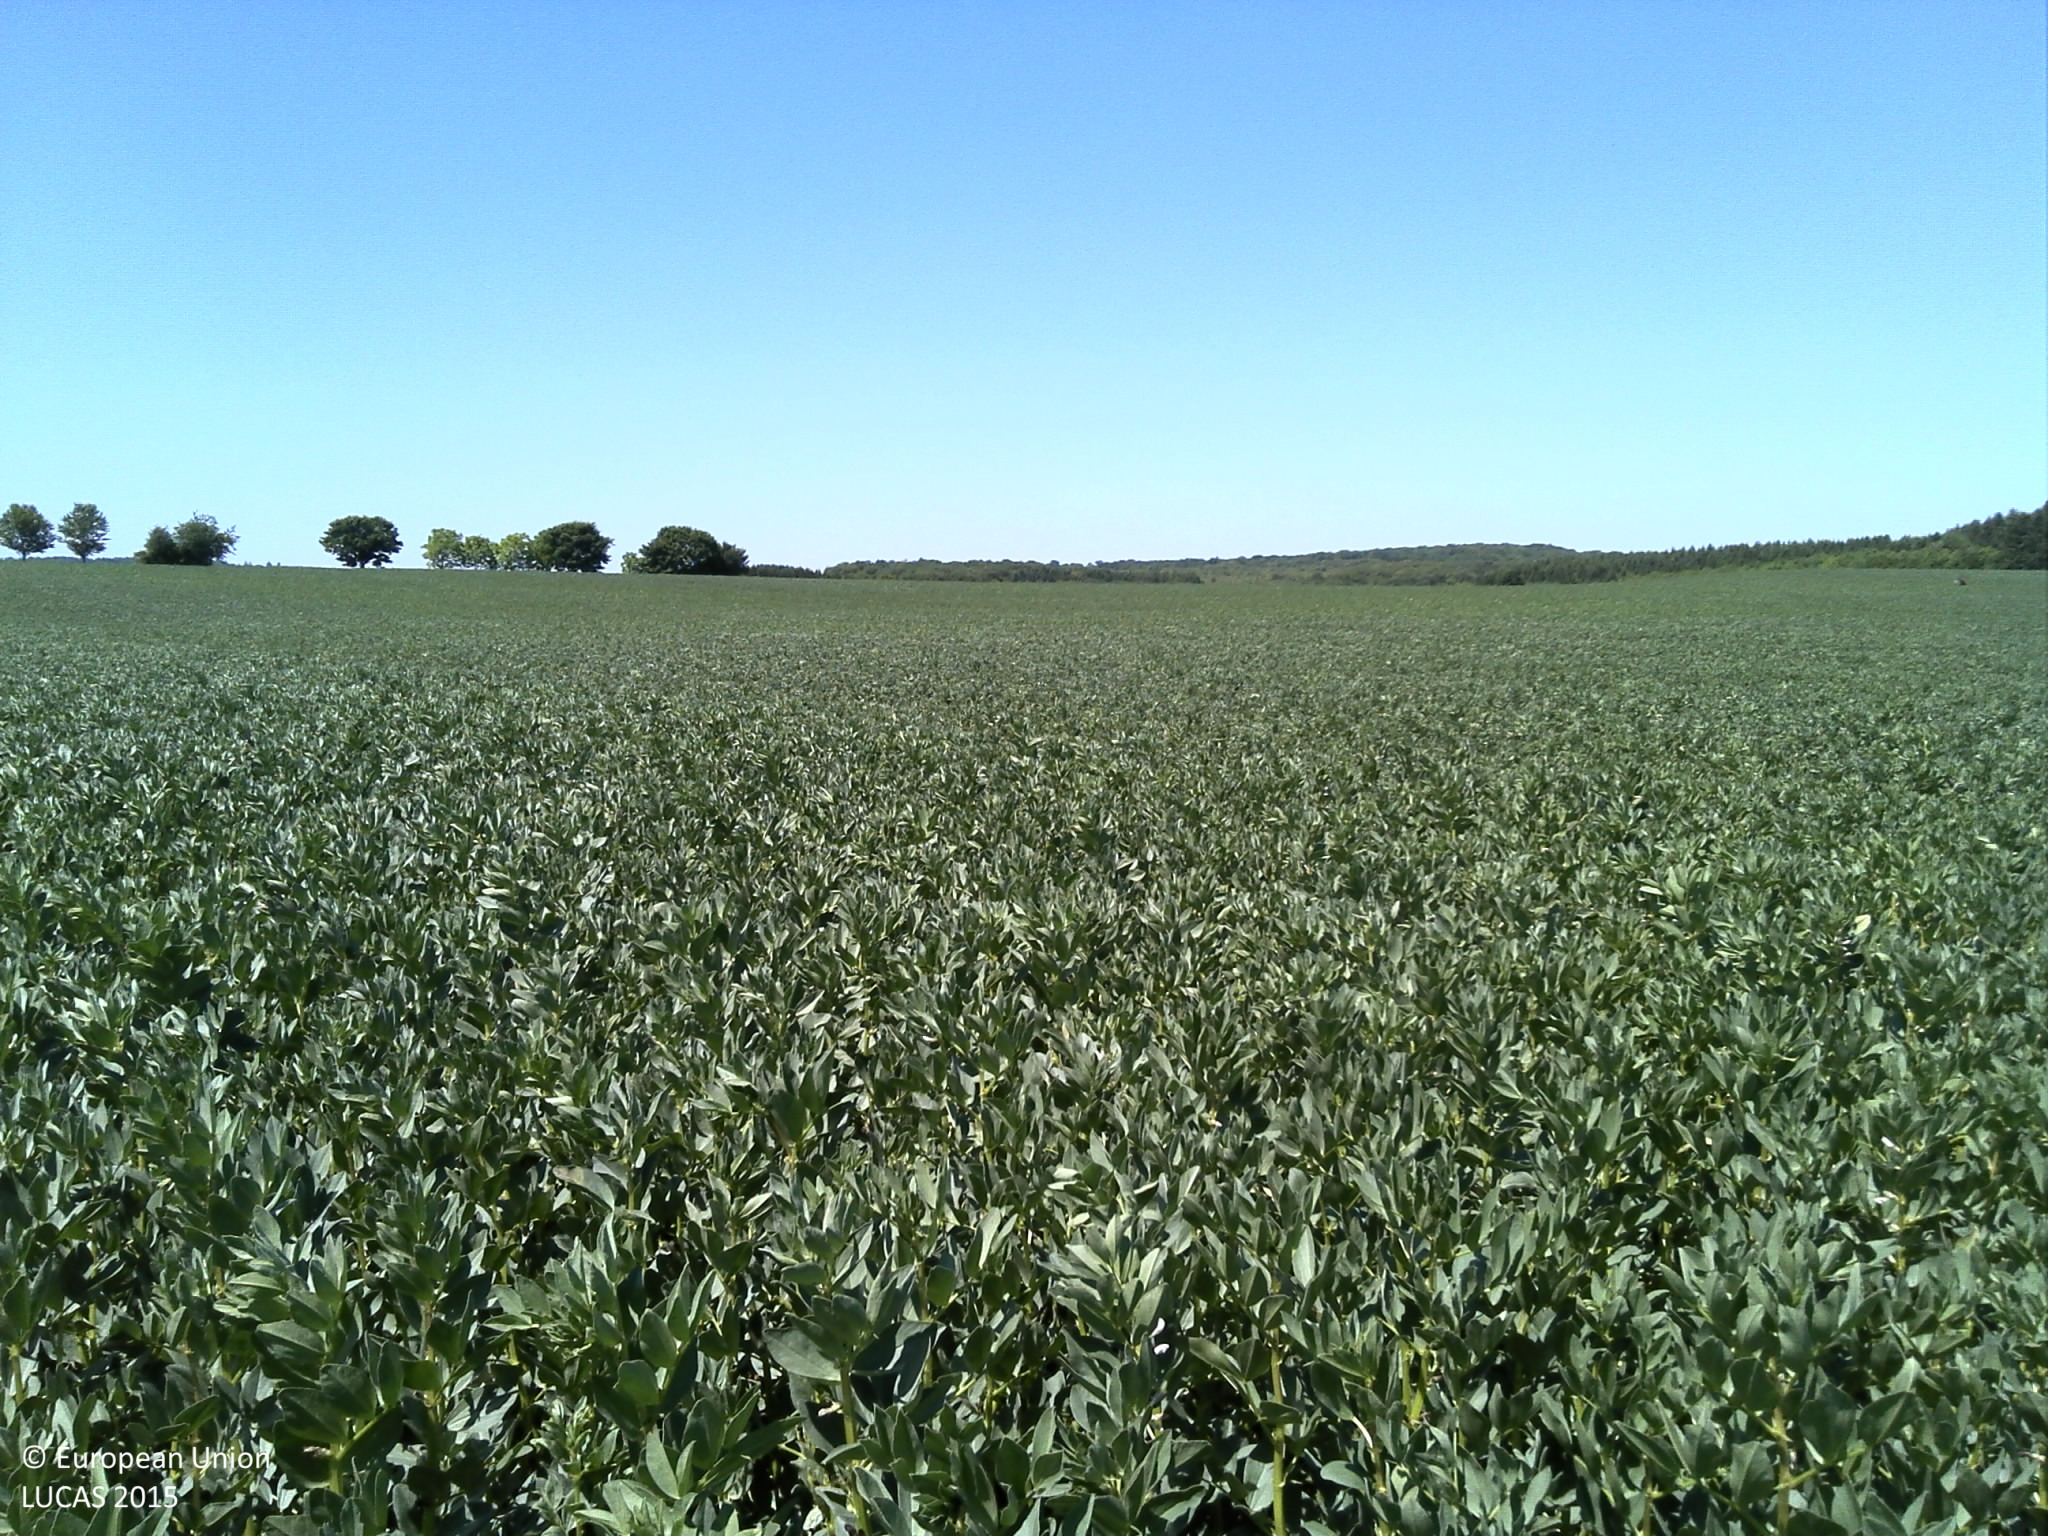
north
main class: Cropland
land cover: Dry pulses
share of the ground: > 75 %
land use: Agriculture (excluding fallow land and kitchen gardens)
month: June
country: FR
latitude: 49.4284
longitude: 5.9595
